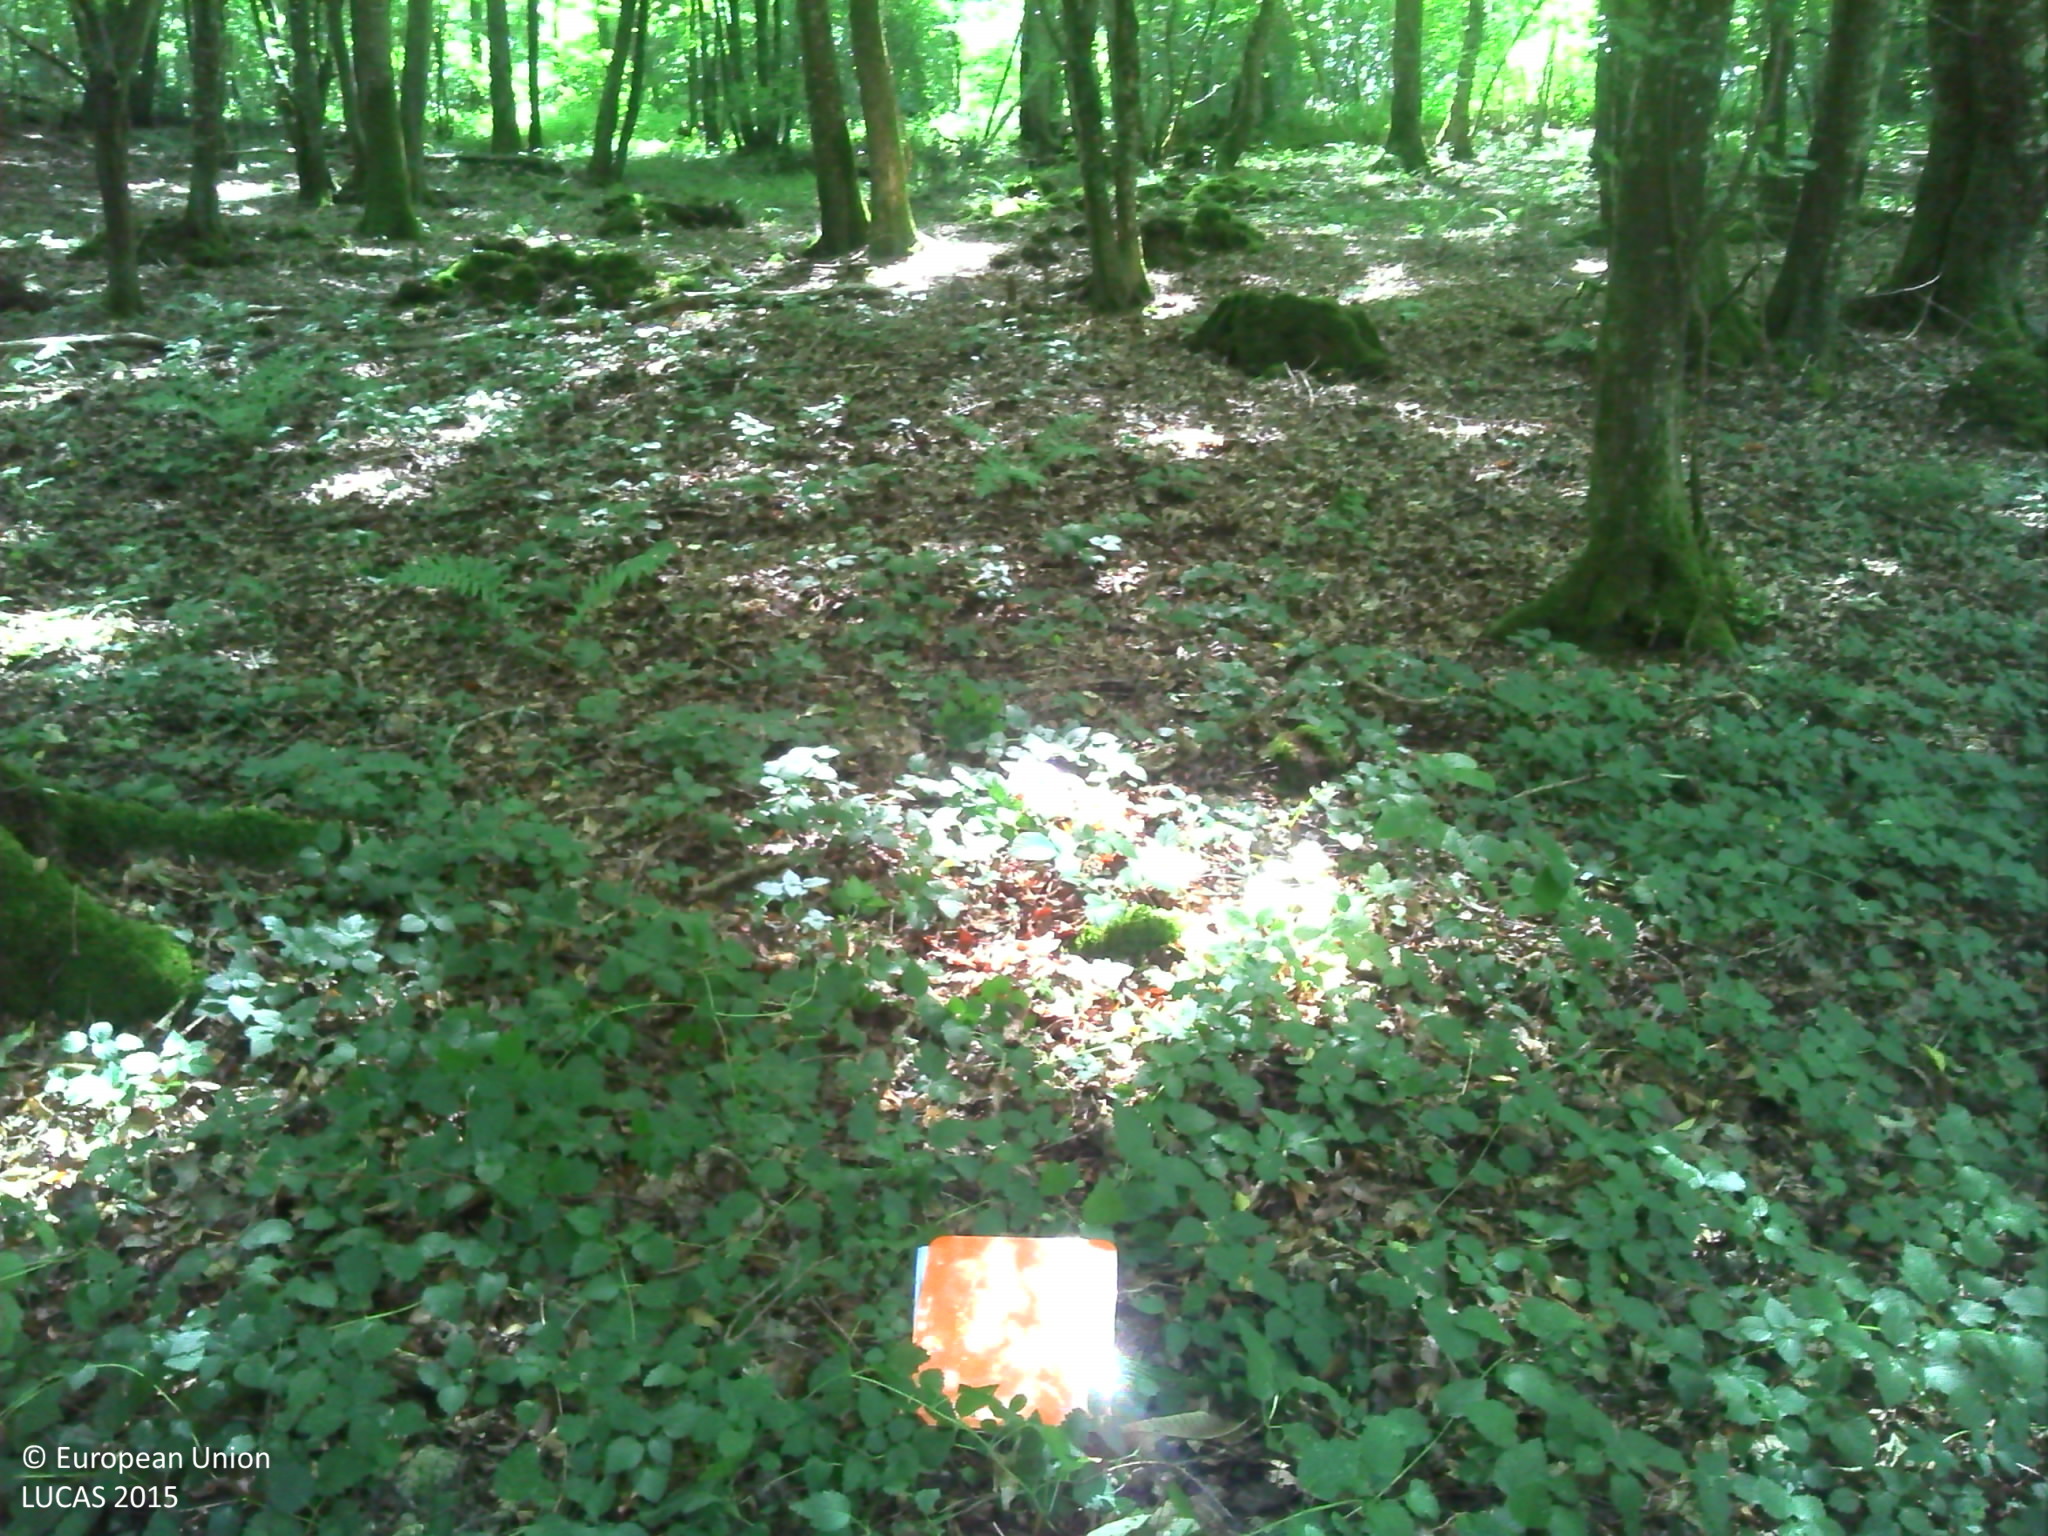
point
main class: Woodland
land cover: Broadleaved woodland
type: mesophytic deciduous forest
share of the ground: > 75 %
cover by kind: broadleaved forest trees 80 %, herbaceous plants 10 %, lichens and mosses 5 %, consolidated bare surface 5 %
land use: Forestry
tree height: > 5 m
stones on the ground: < 10 %
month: June
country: FR
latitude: 49.0930
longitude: 1.0913
